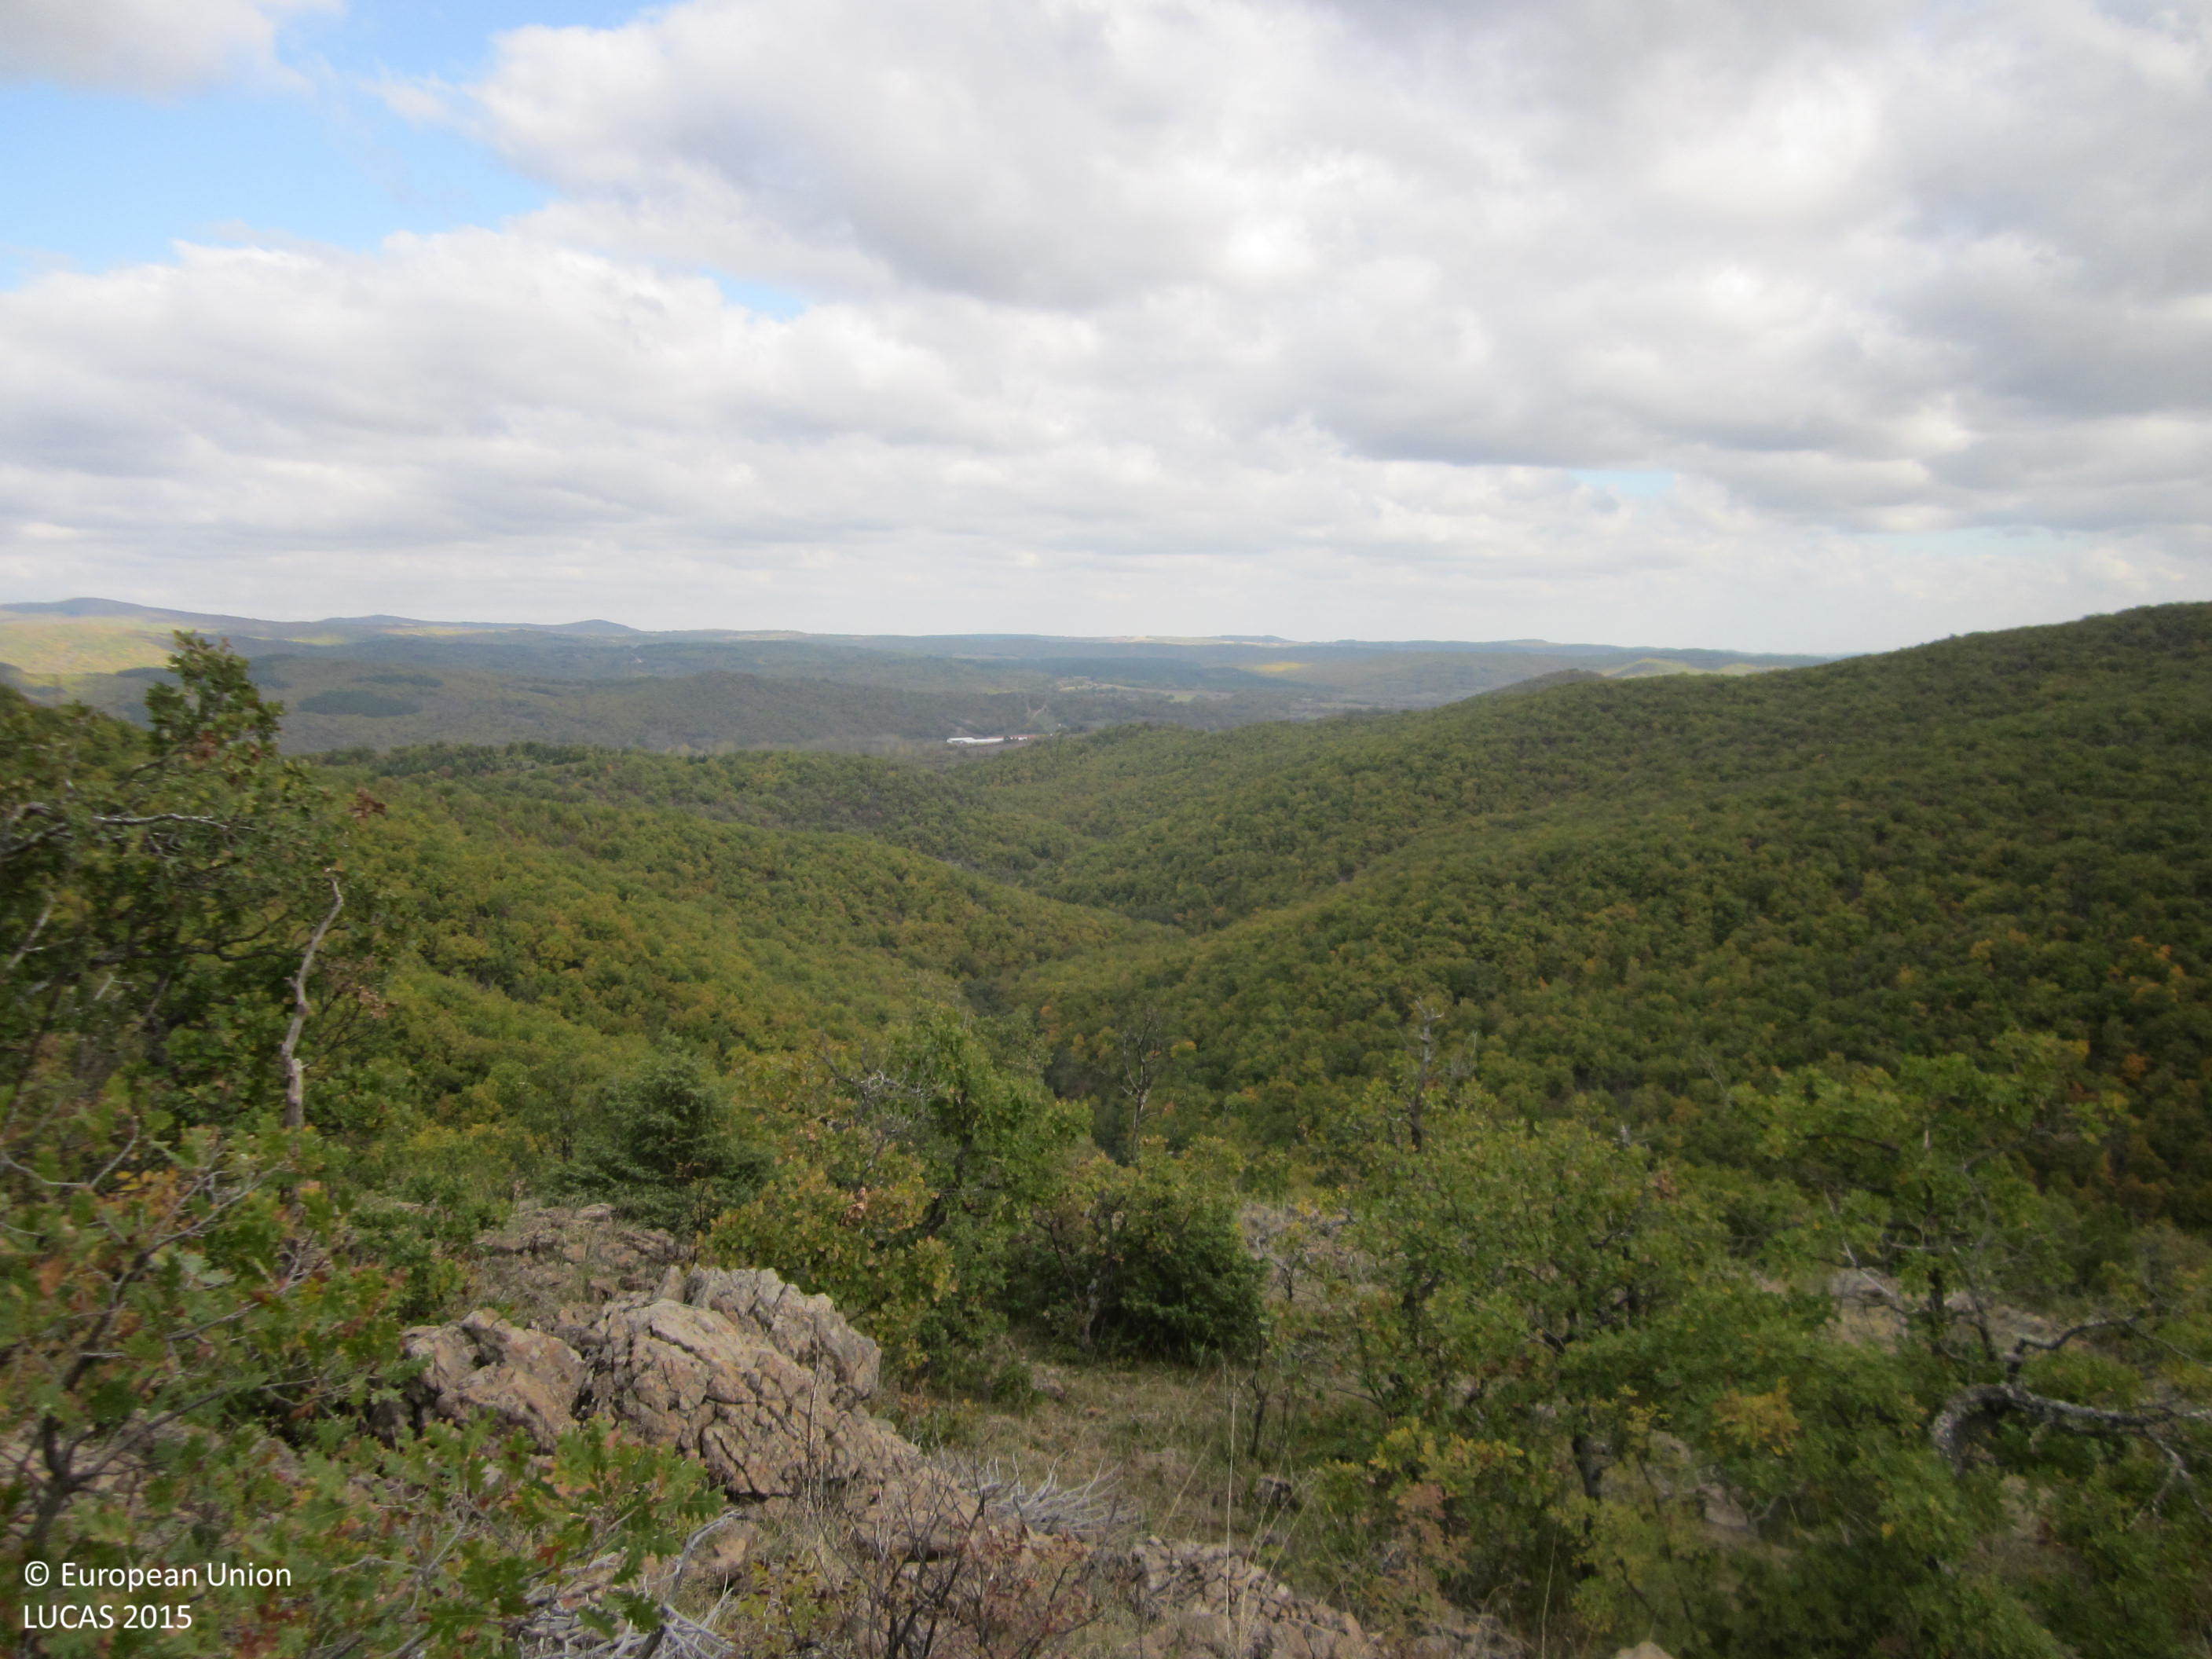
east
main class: Woodland
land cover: Broadleaved woodland
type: mesophytic deciduous forest
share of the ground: > 75 %
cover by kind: broadleaved forest trees 100 %
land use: Forestry
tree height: > 5 m
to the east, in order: Broadleaved woodland; Rivers and streams; Broadleaved woodland
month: November
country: BG
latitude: 41.4085
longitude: 25.8908
